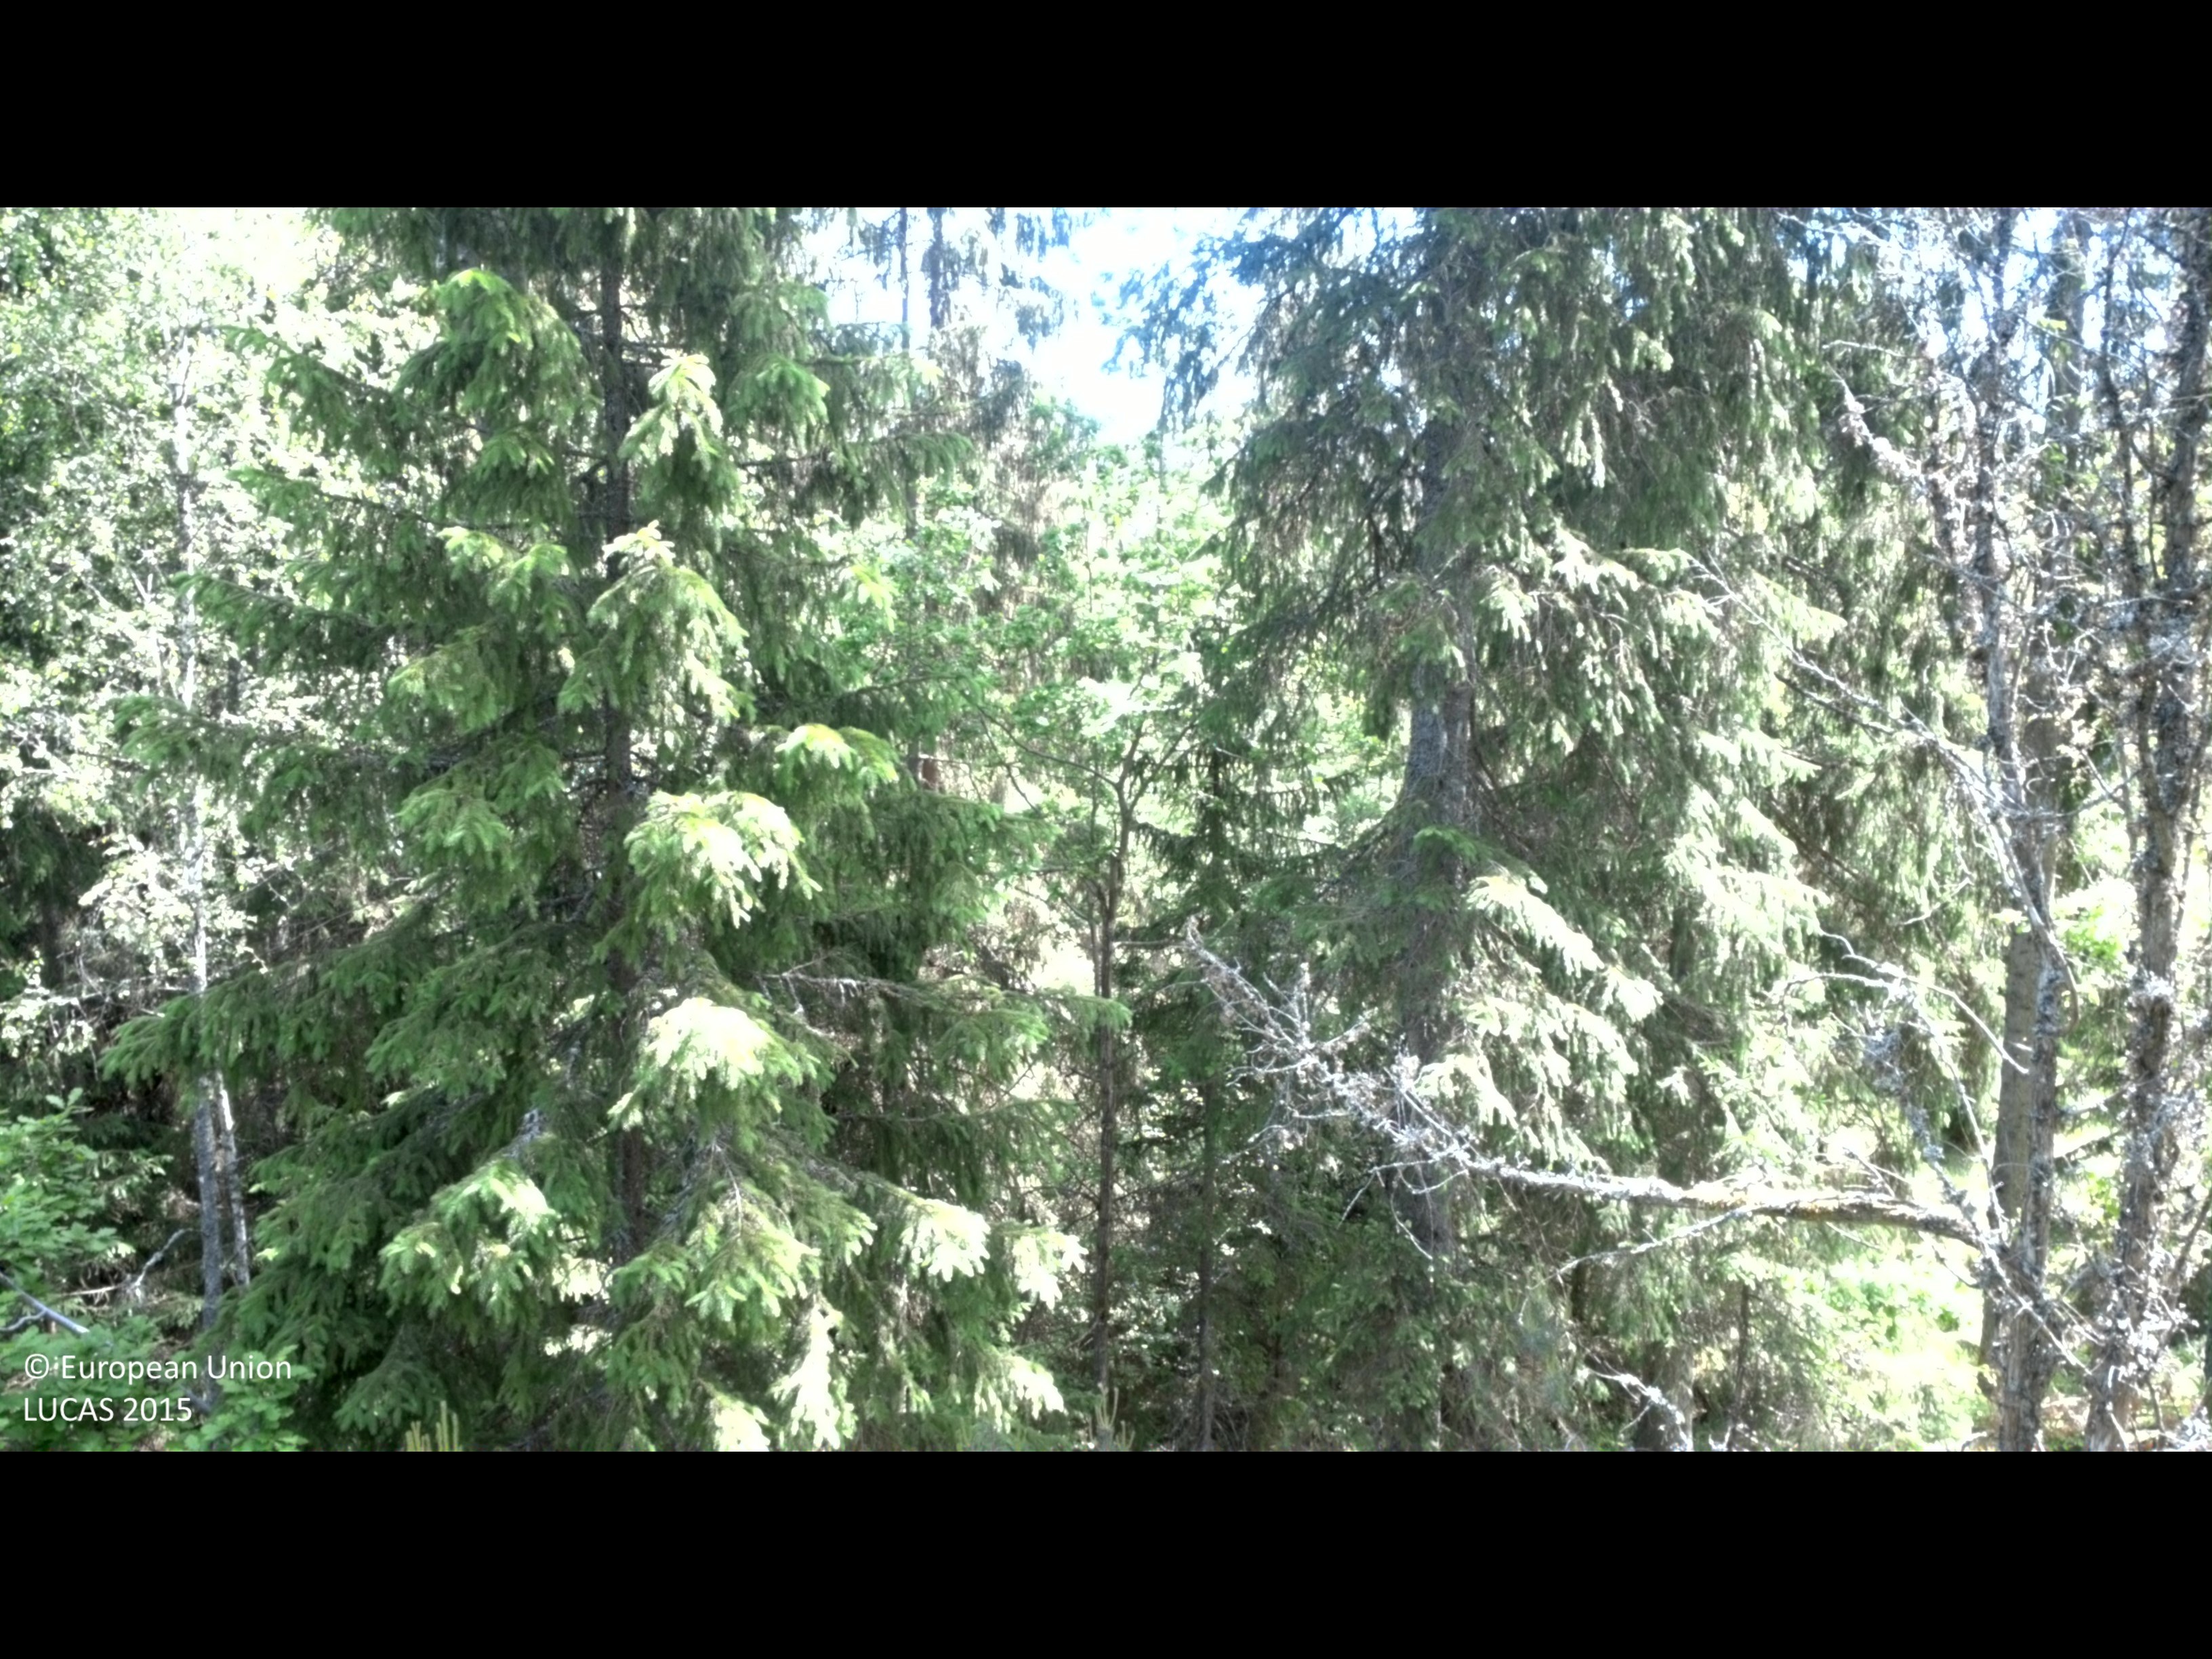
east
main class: Woodland
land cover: Spruce dominated coniferous woodland
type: boreal forest
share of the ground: 50 - 75 %
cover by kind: coniferous forest trees 45 %, shrubs 35 %, broadleaved forest trees 10 %, lichens and mosses 10 %
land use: Forestry
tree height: > 5 m
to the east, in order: Spruce dominated coniferous woodland; Rivers and streams; Spruce dominated mixed woodland; Broadleaved woodland; Pine dominated coniferous woodland; Rock outcrops; Spruce dominated mixed woodland; Electric lines; Other mixed woodland
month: June
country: SE
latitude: 57.6463
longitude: 16.5162
